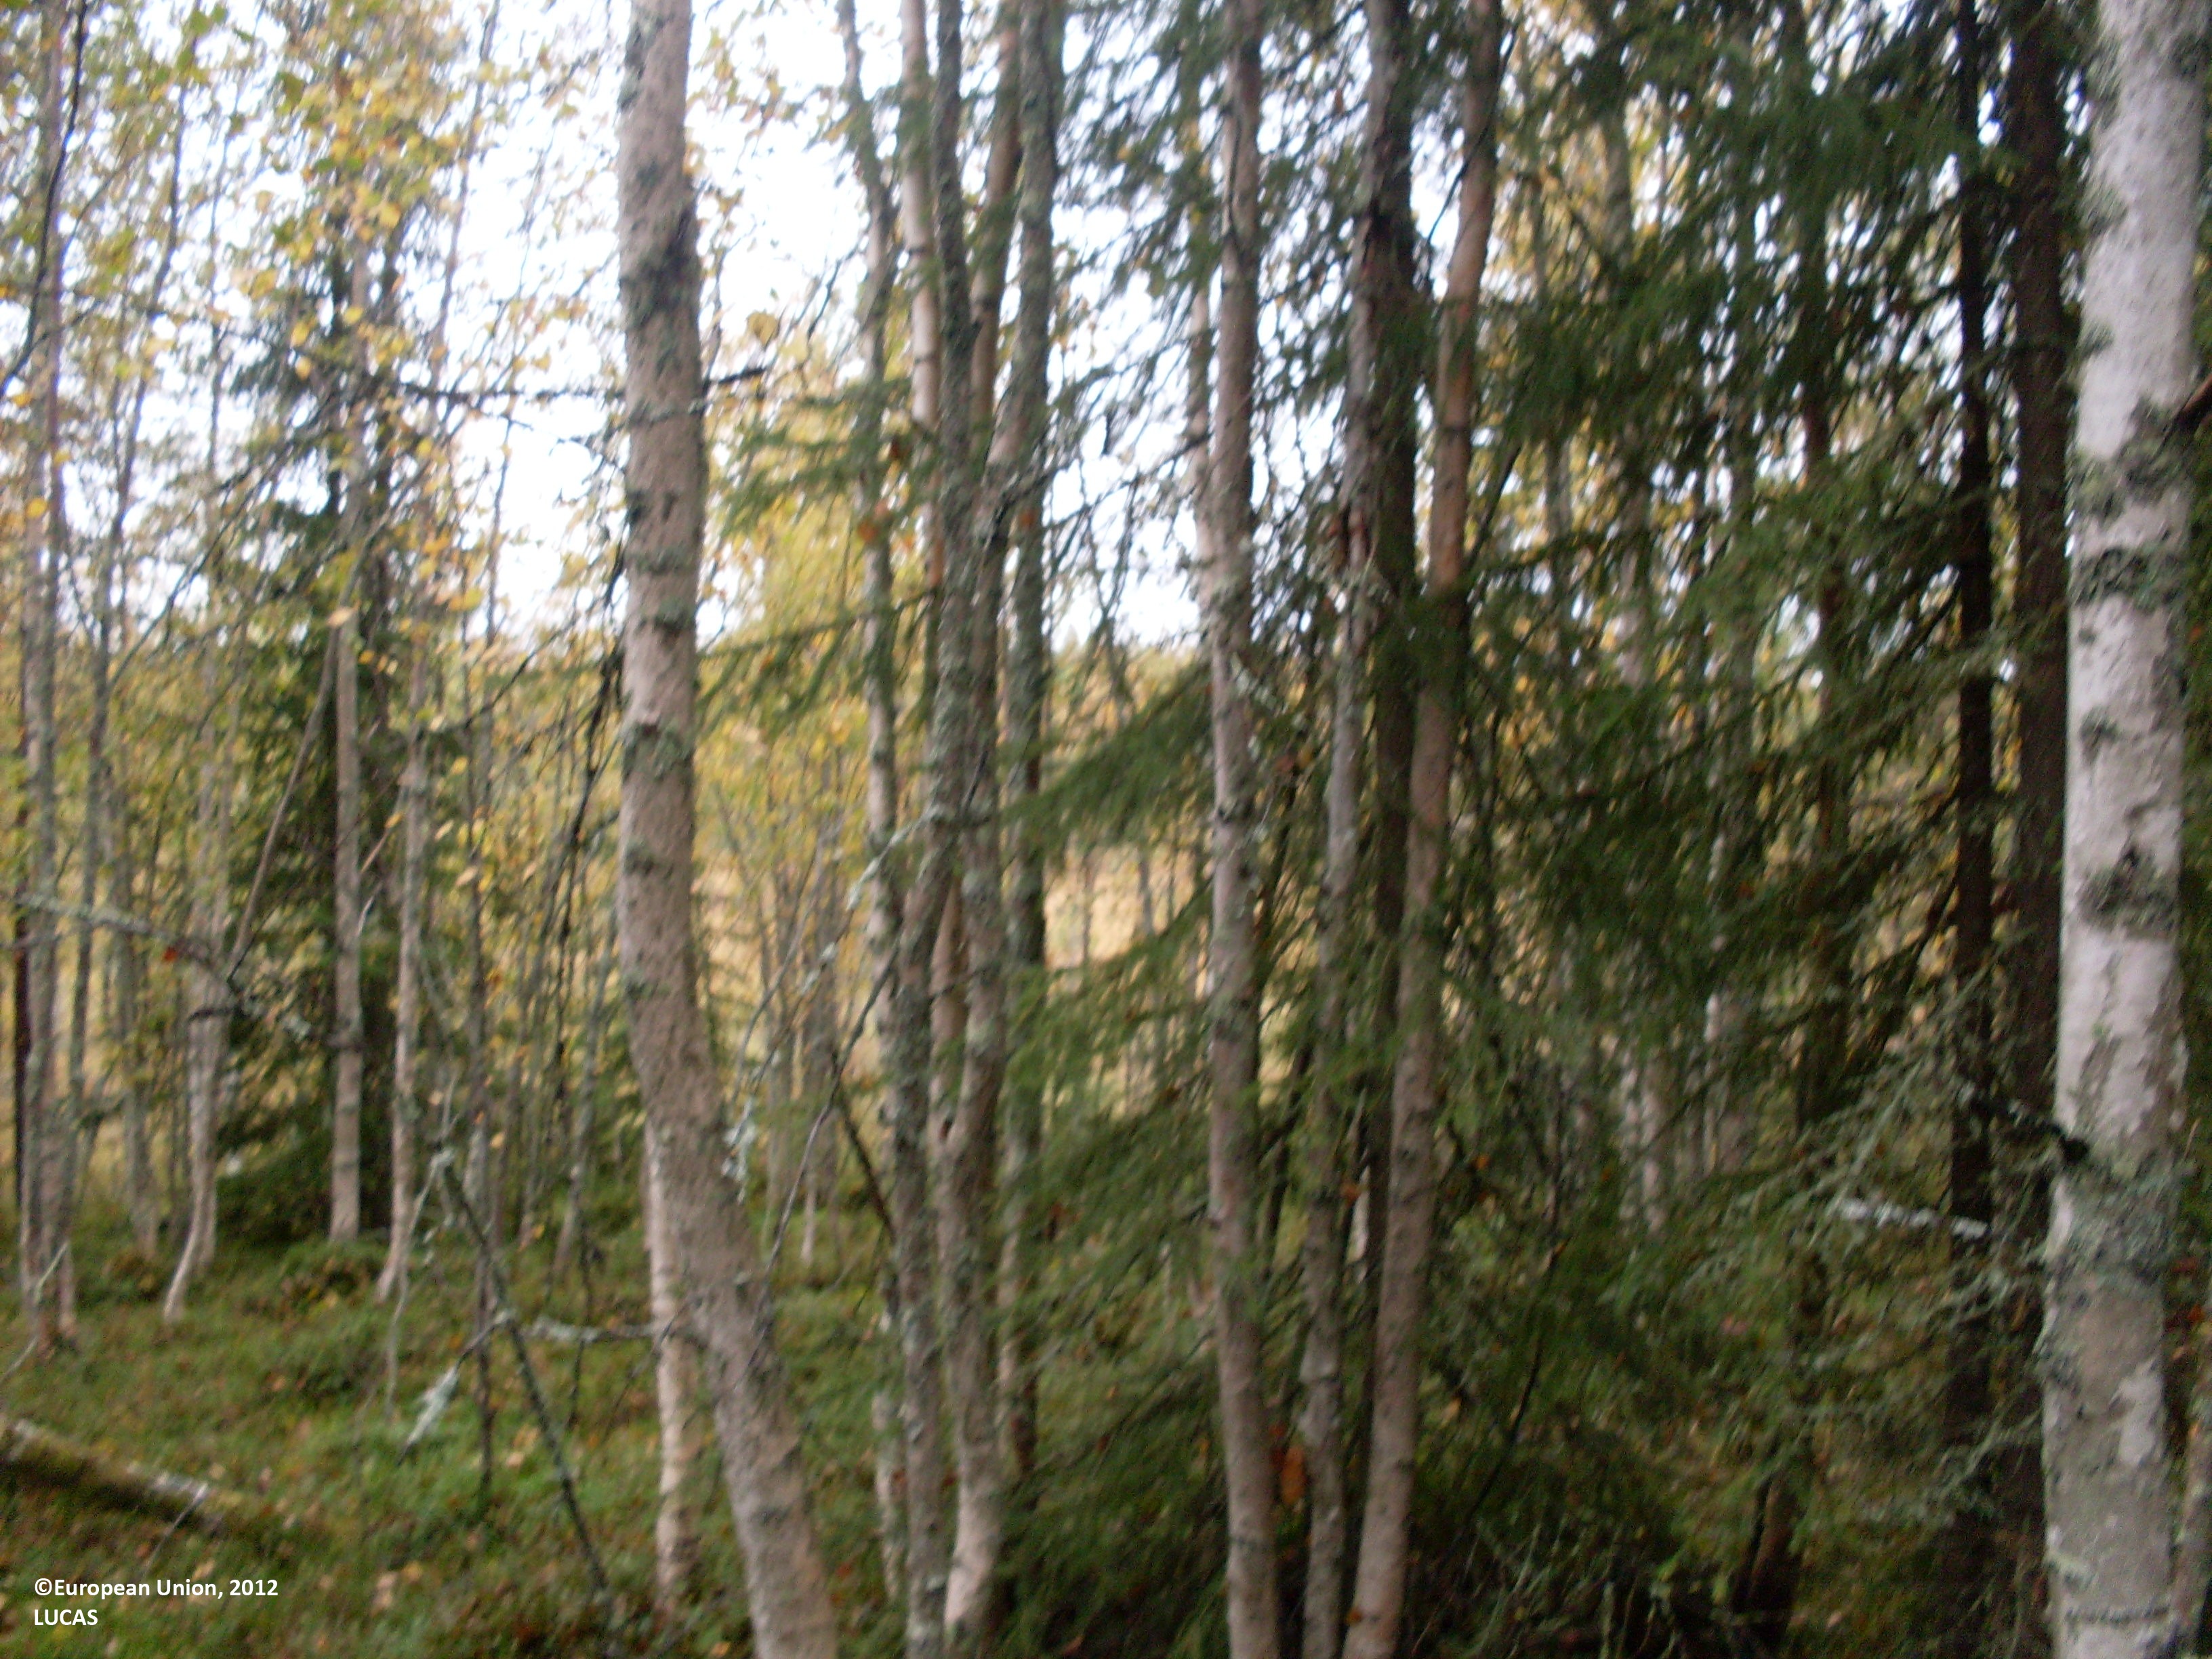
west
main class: Woodland
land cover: Spruce dominated mixed woodland
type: boreal forest
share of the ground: > 75 %
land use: Forestry
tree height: > 5 m
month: September
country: FI
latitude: 64.2140
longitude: 30.2550
